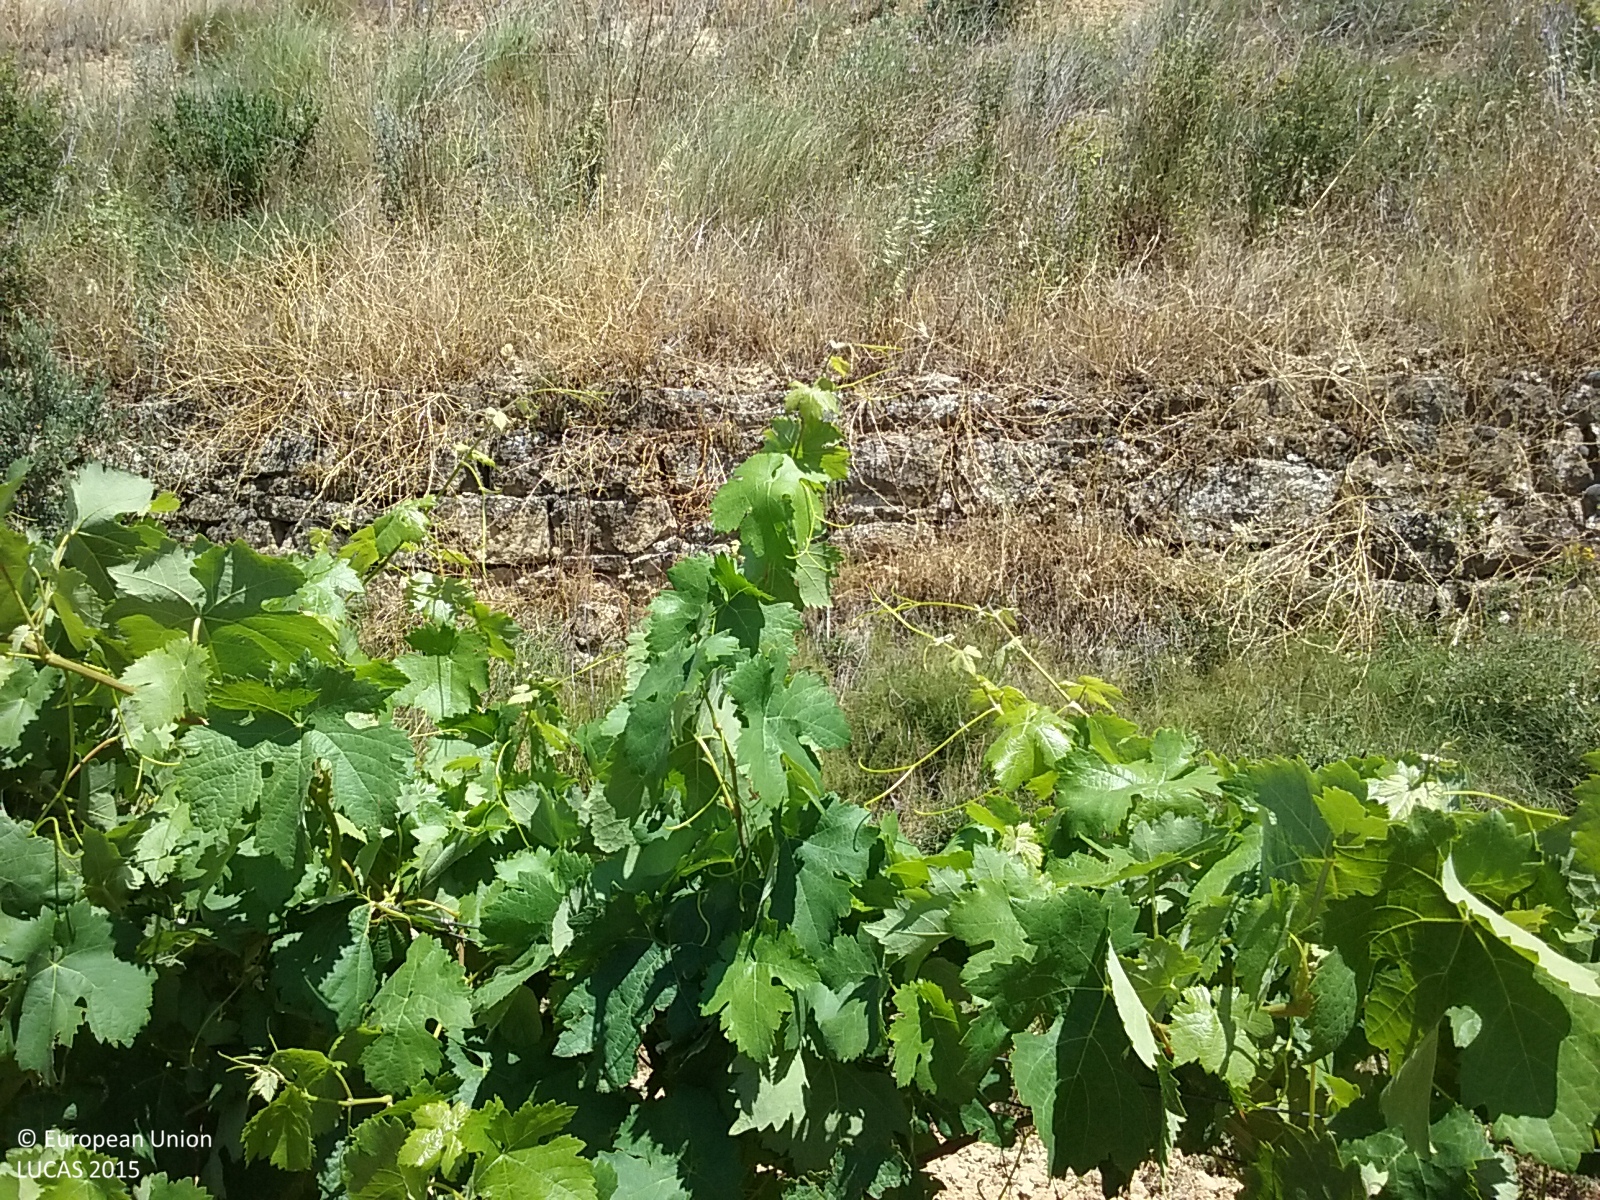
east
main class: Cropland
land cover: Vineyards
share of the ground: 10 - 25 %
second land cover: Other bare soil
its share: > 75 %
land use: Agriculture (excluding fallow land and kitchen gardens)
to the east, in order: Vineyards; Other bare soil; Dry stone walls; Grassland with sparse tree/shrub cover; Vineyards; Dry stone walls; Olive groves; Tracks; Dry stone walls; Vineyards; Grass margins; Tracks; Vineyards; Tracks; Dry stone walls; Vineyards
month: June
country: ES
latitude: 41.0996
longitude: 0.3344
